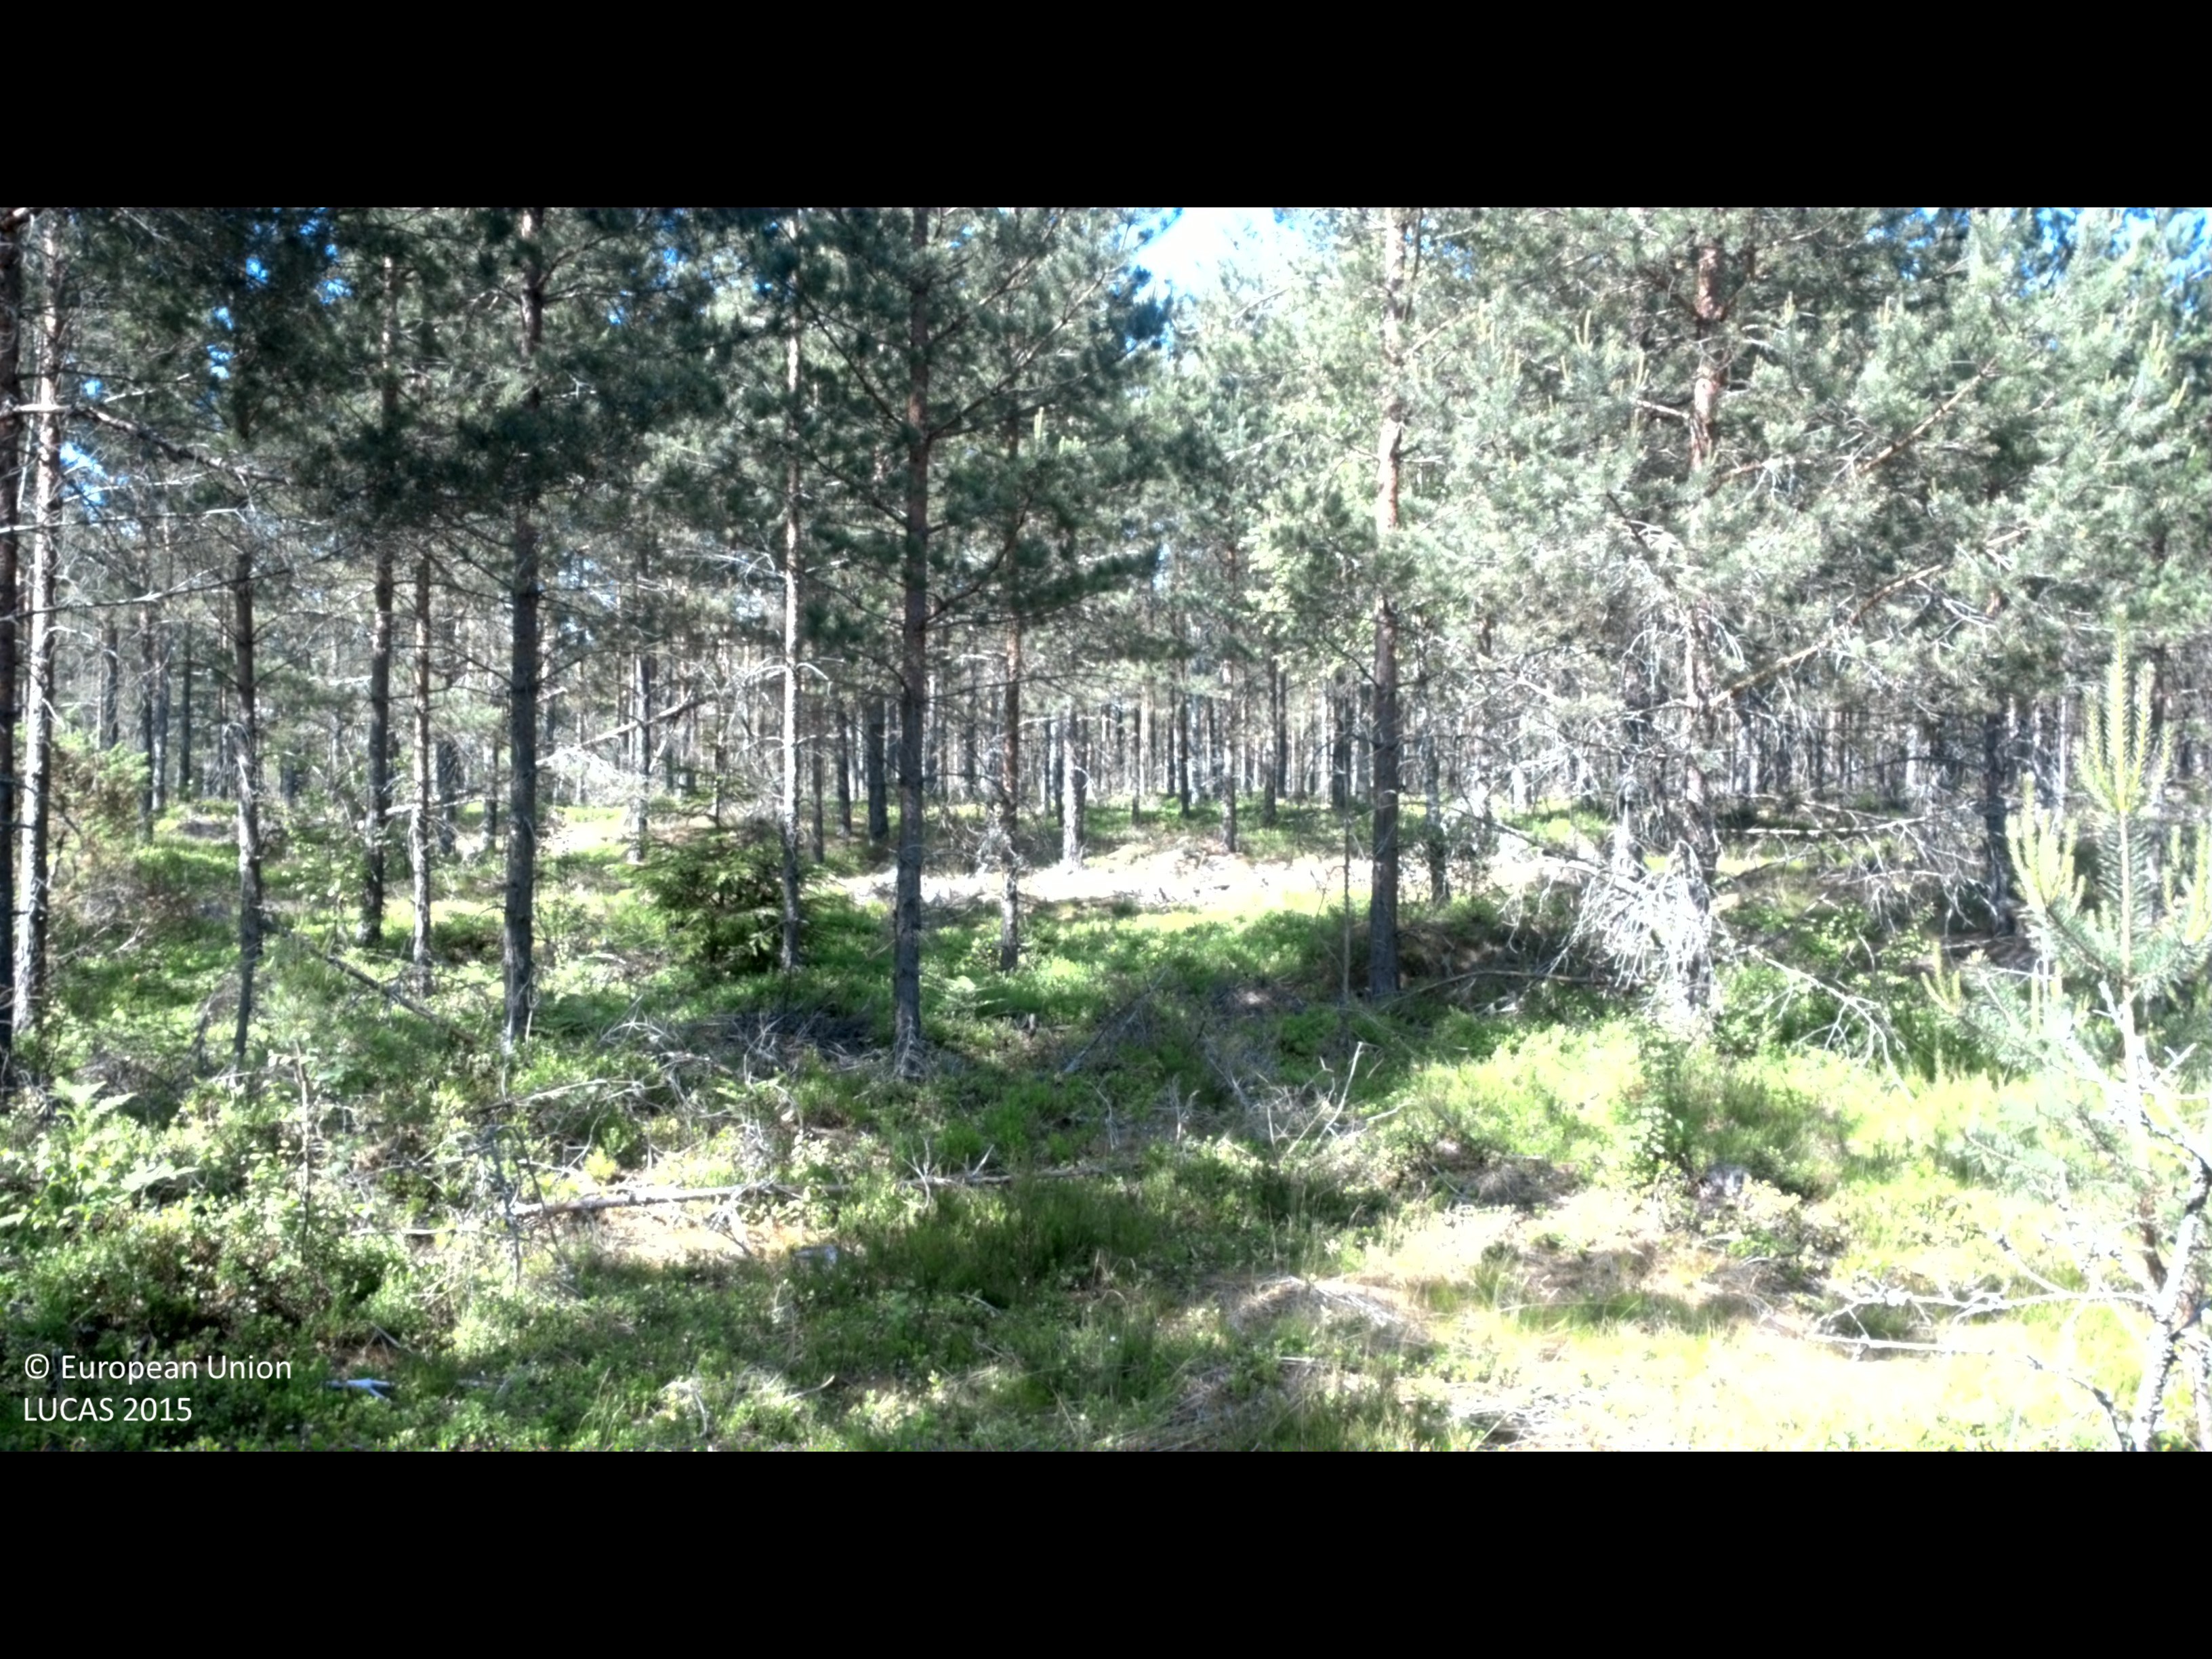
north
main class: Woodland
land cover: Pine dominated coniferous woodland
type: boreal forest
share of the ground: 50 - 75 %
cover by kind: coniferous forest trees 60 %, shrubs 20 %, herbaceous plants 10 %, broadleaved forest trees 5 %, lichens and mosses 5 %
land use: Forestry
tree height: > 5 m
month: June
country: SE
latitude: 57.6414
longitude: 16.6162
